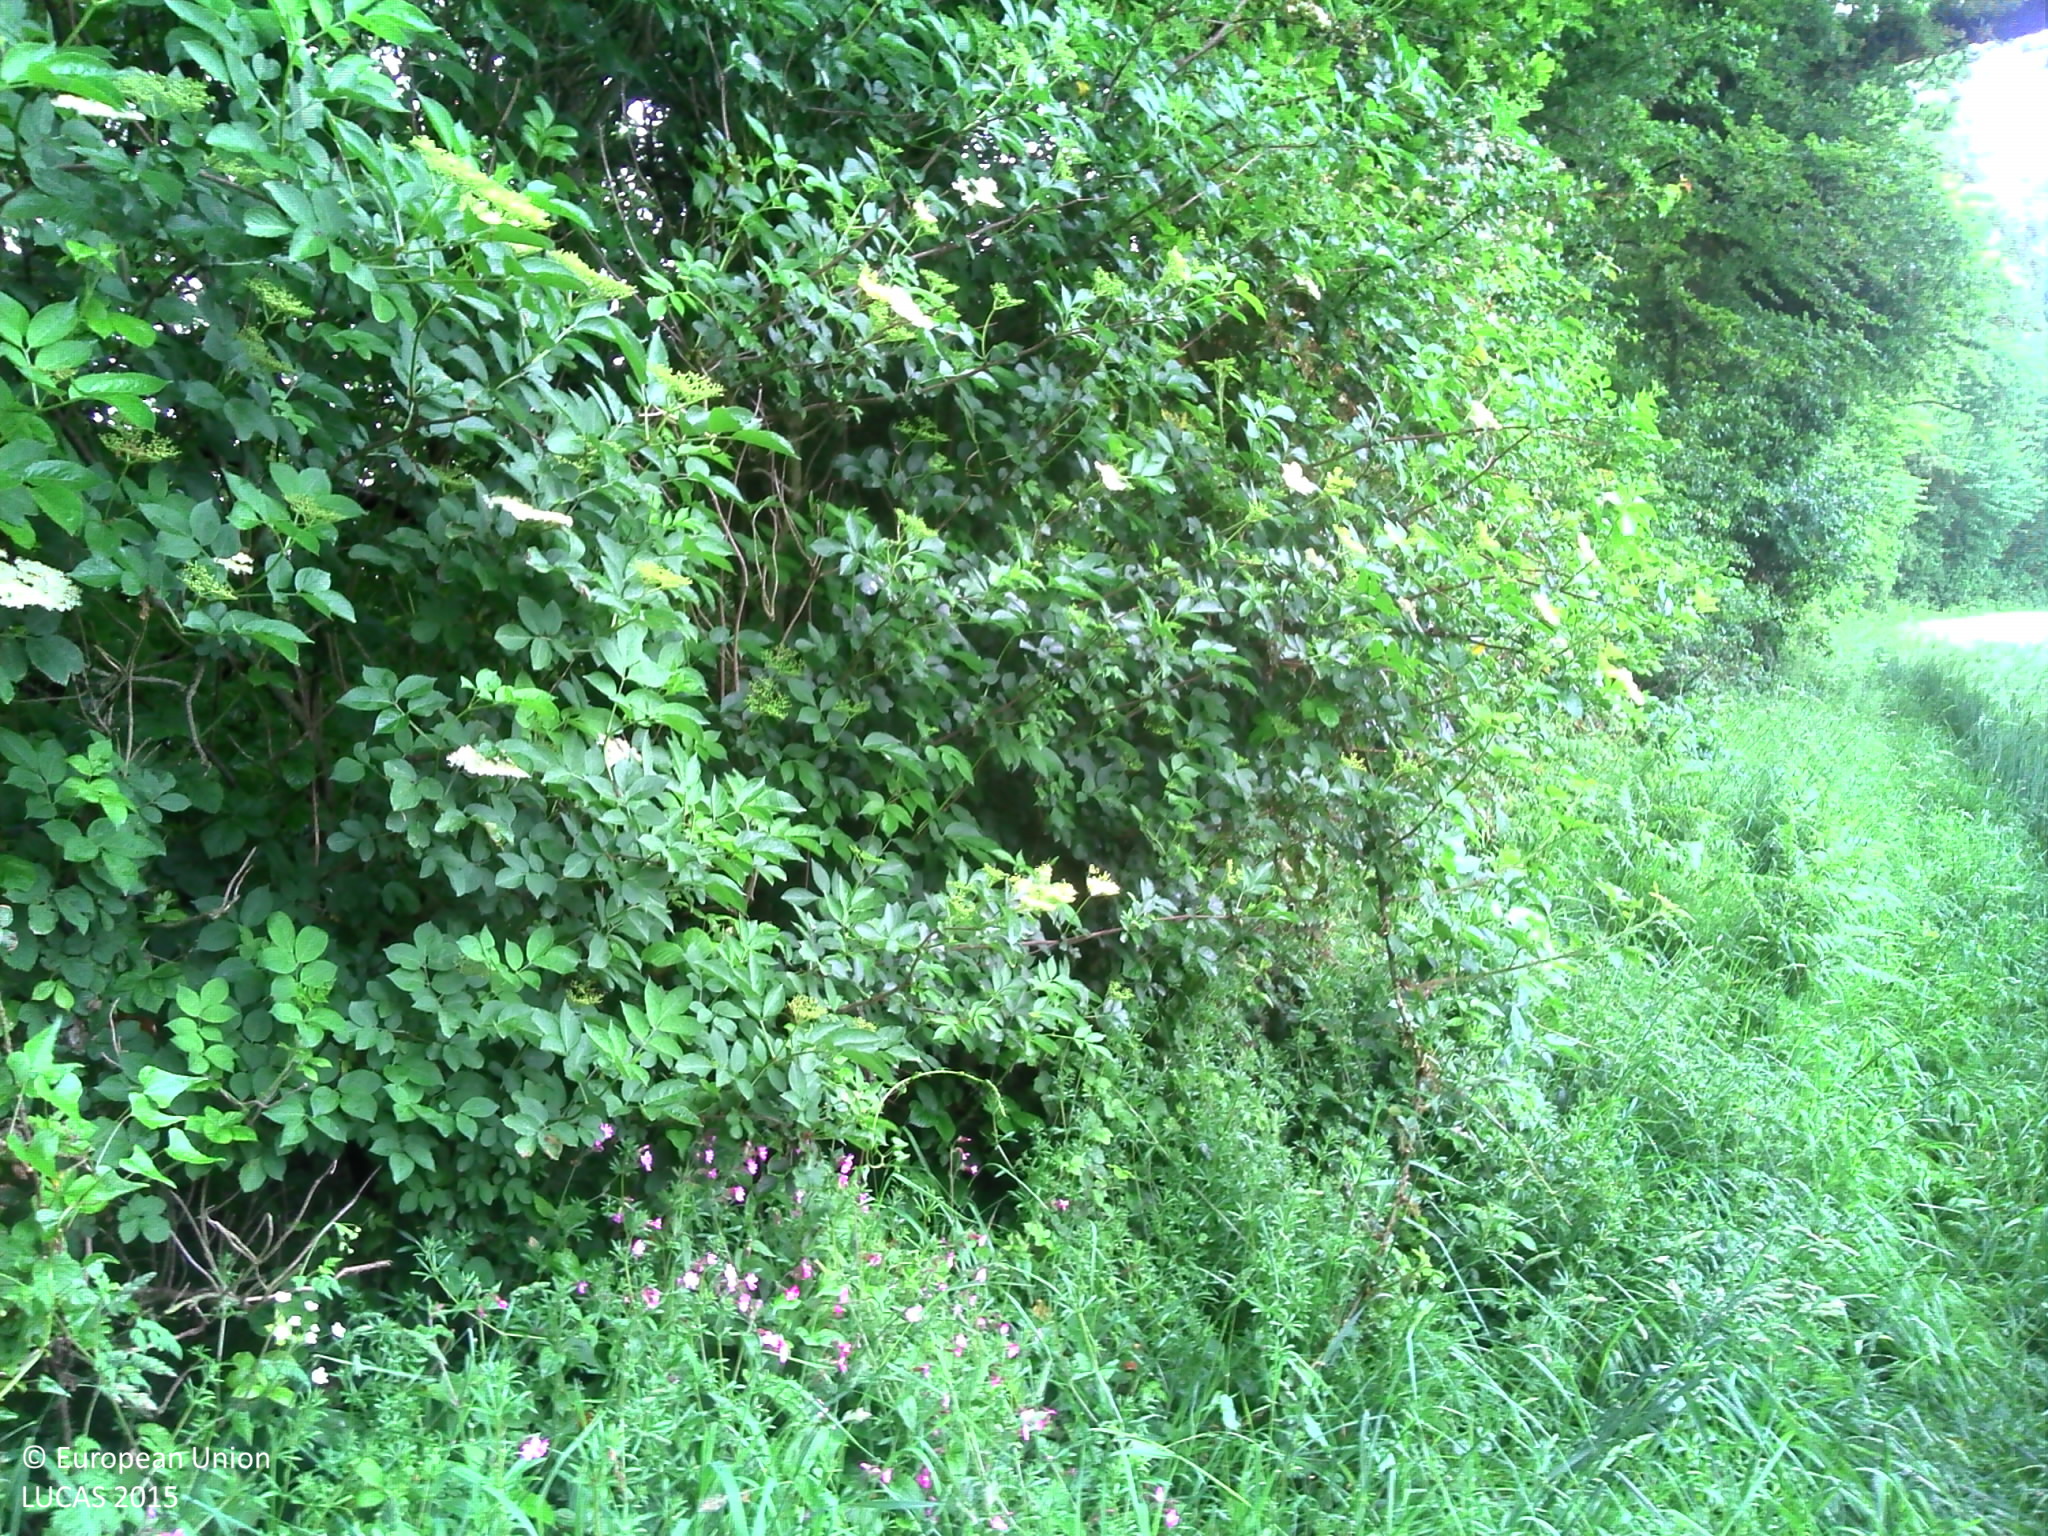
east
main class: Cropland
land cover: Barley
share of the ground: > 75 %
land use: Agriculture (excluding fallow land and kitchen gardens)
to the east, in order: Barley; Grass margins; Abandoned hedges; Tracks; Abandoned hedges; Grass margins; Barley; Lines of trees; Grassland without tree/shrub cover; Electric lines; Grassland without tree/shrub cover; Artificial constructions in urban areas
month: June
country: FR
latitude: 49.5251
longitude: -1.6983
